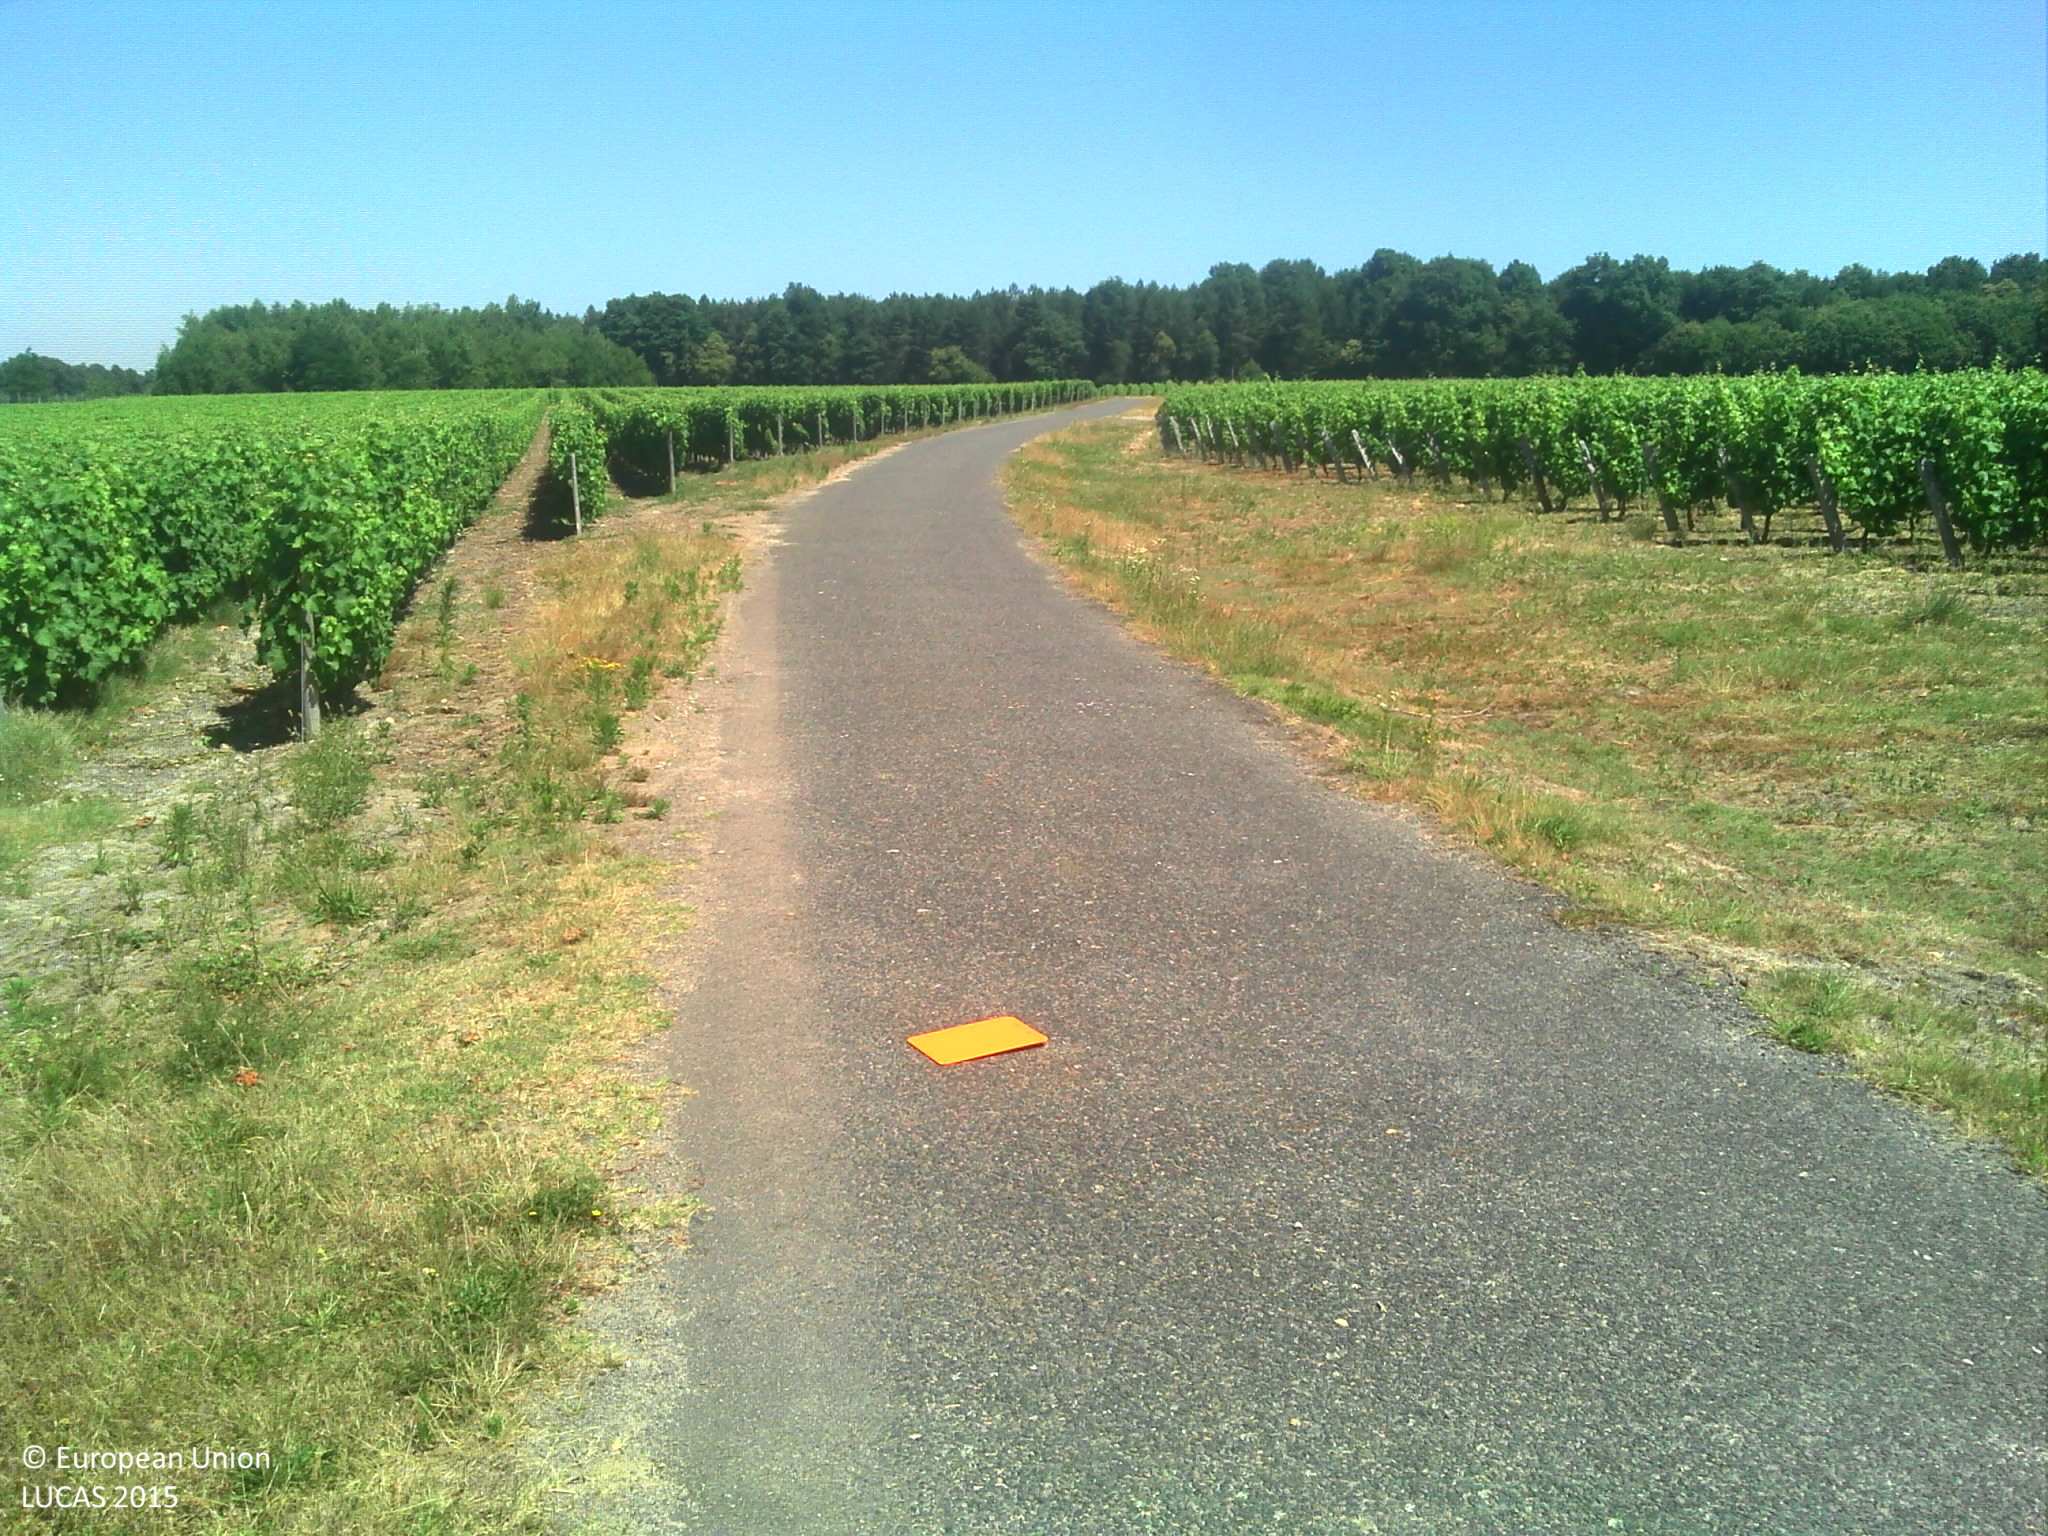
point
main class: Grassland
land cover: Grassland without tree/shrub cover
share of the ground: > 75 %
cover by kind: herbaceous plants 80 %, unconsolidated bare surface 20 %
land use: Agriculture (excluding fallow land and kitchen gardens)
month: June
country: FR
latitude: 47.3059
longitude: 1.3754
